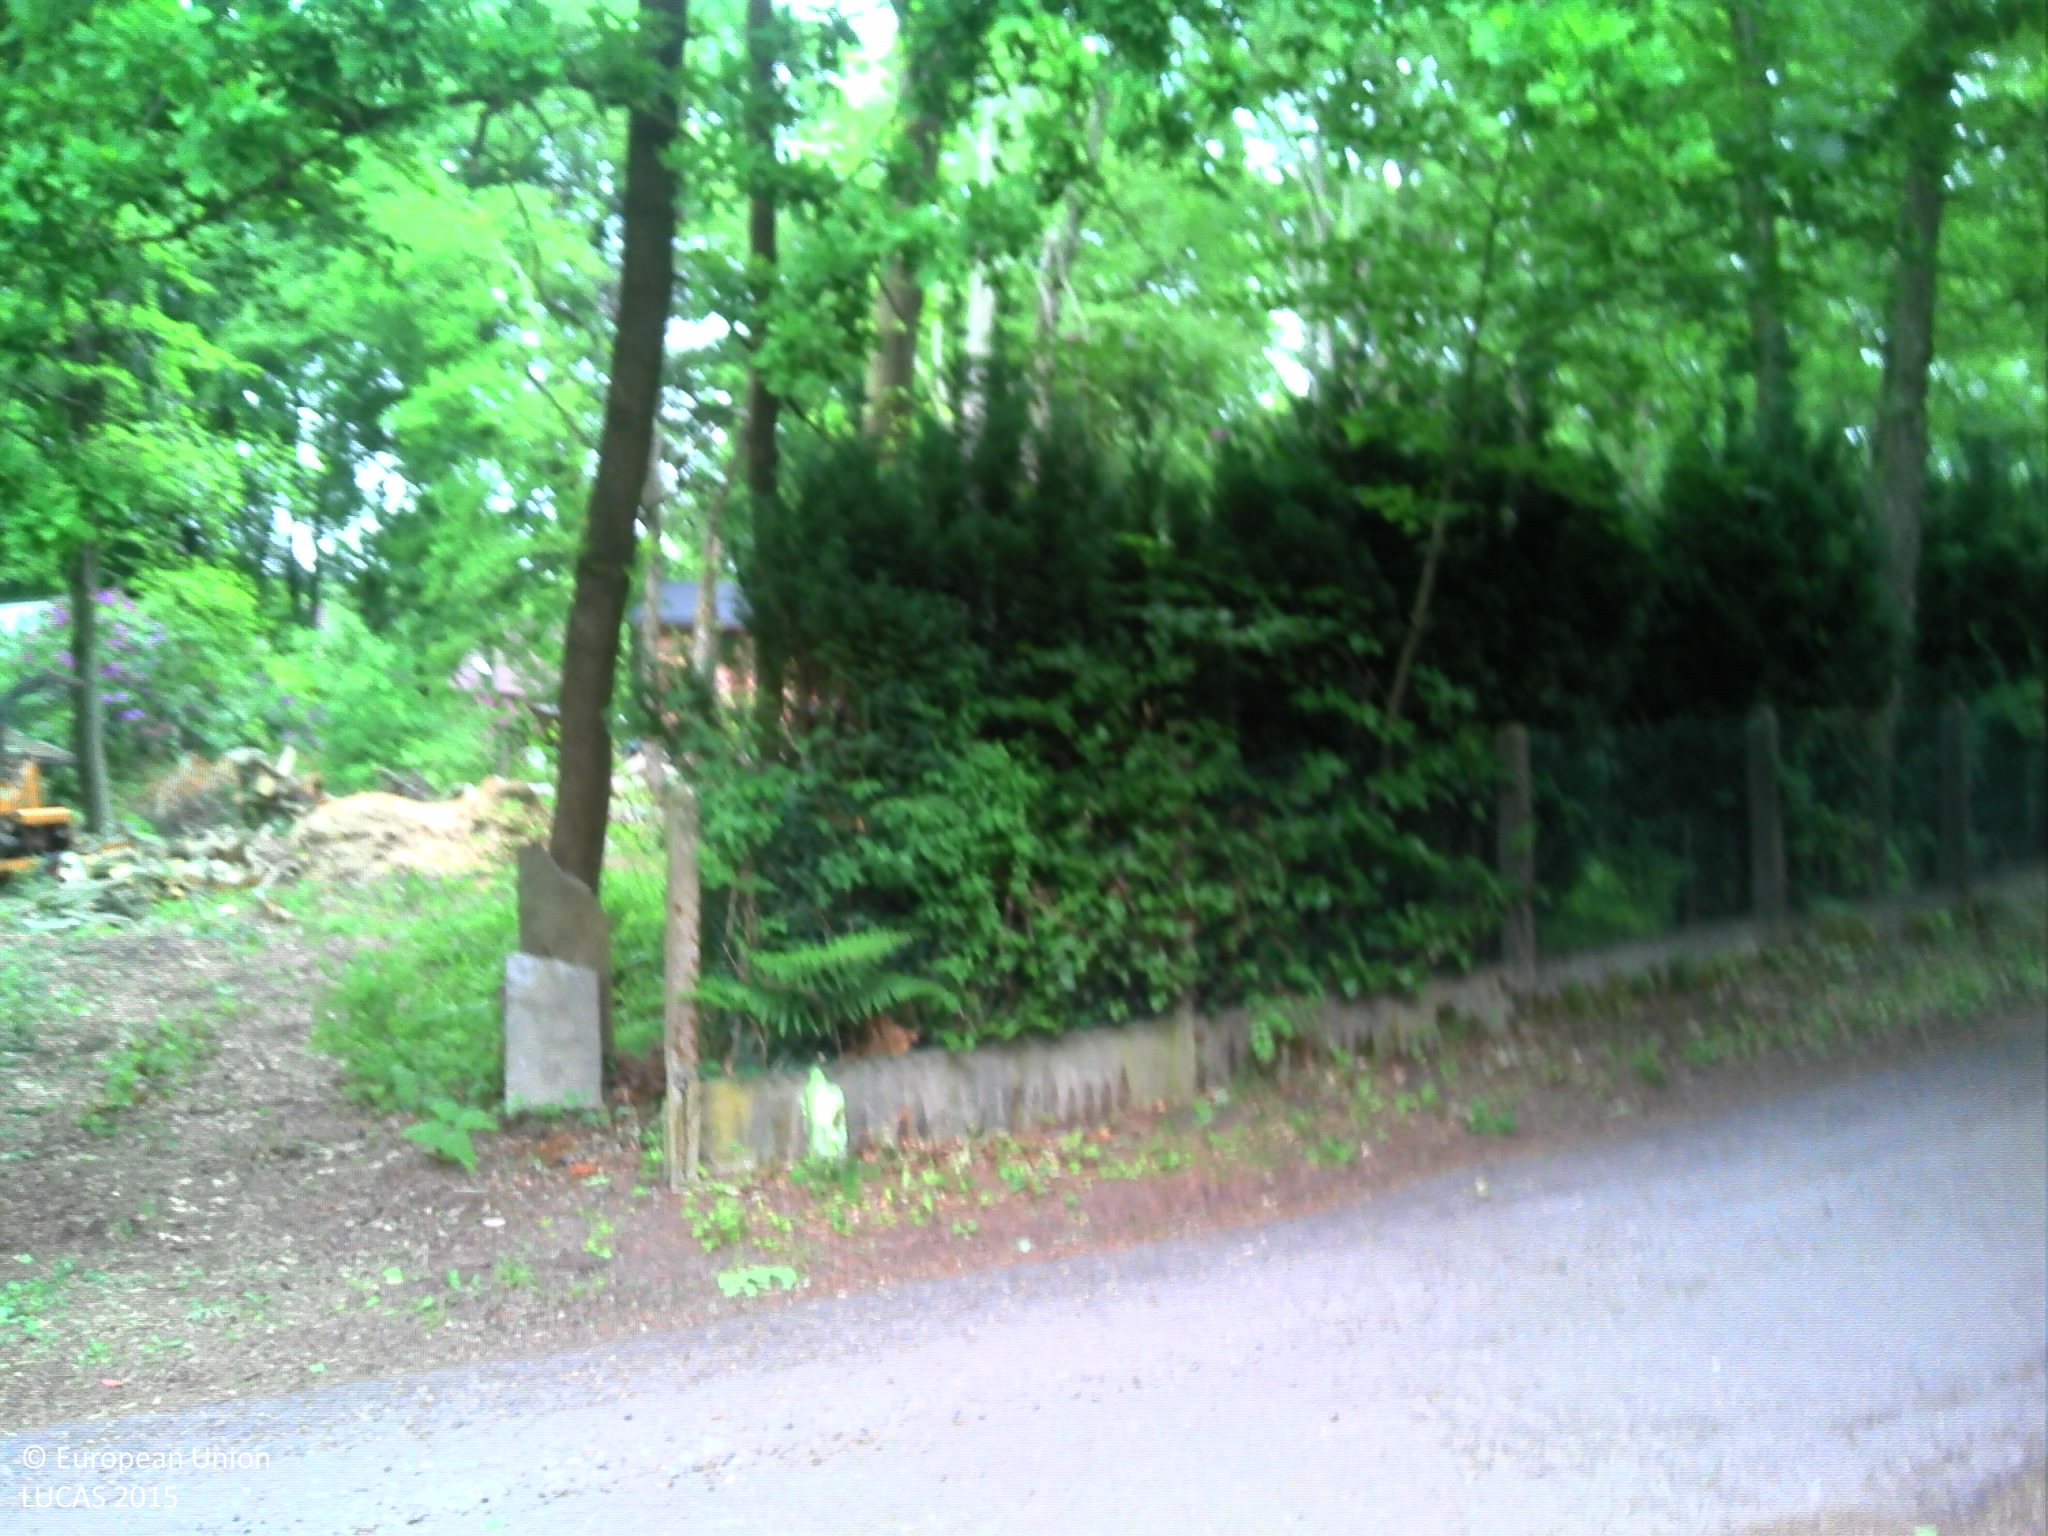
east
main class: Grassland
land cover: Grassland with sparse tree/shrub cover
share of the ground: > 75 %
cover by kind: herbaceous plants 95 %, broadleaved forest trees 5 %
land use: Residential
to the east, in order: Grassland with sparse tree/shrub cover; Artificial constructions in urban areas; Broadleaved woodland; Artificial constructions in urban areas; Fences; Grassland without tree/shrub cover
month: May
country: BE
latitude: 50.6872
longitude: 4.6032
